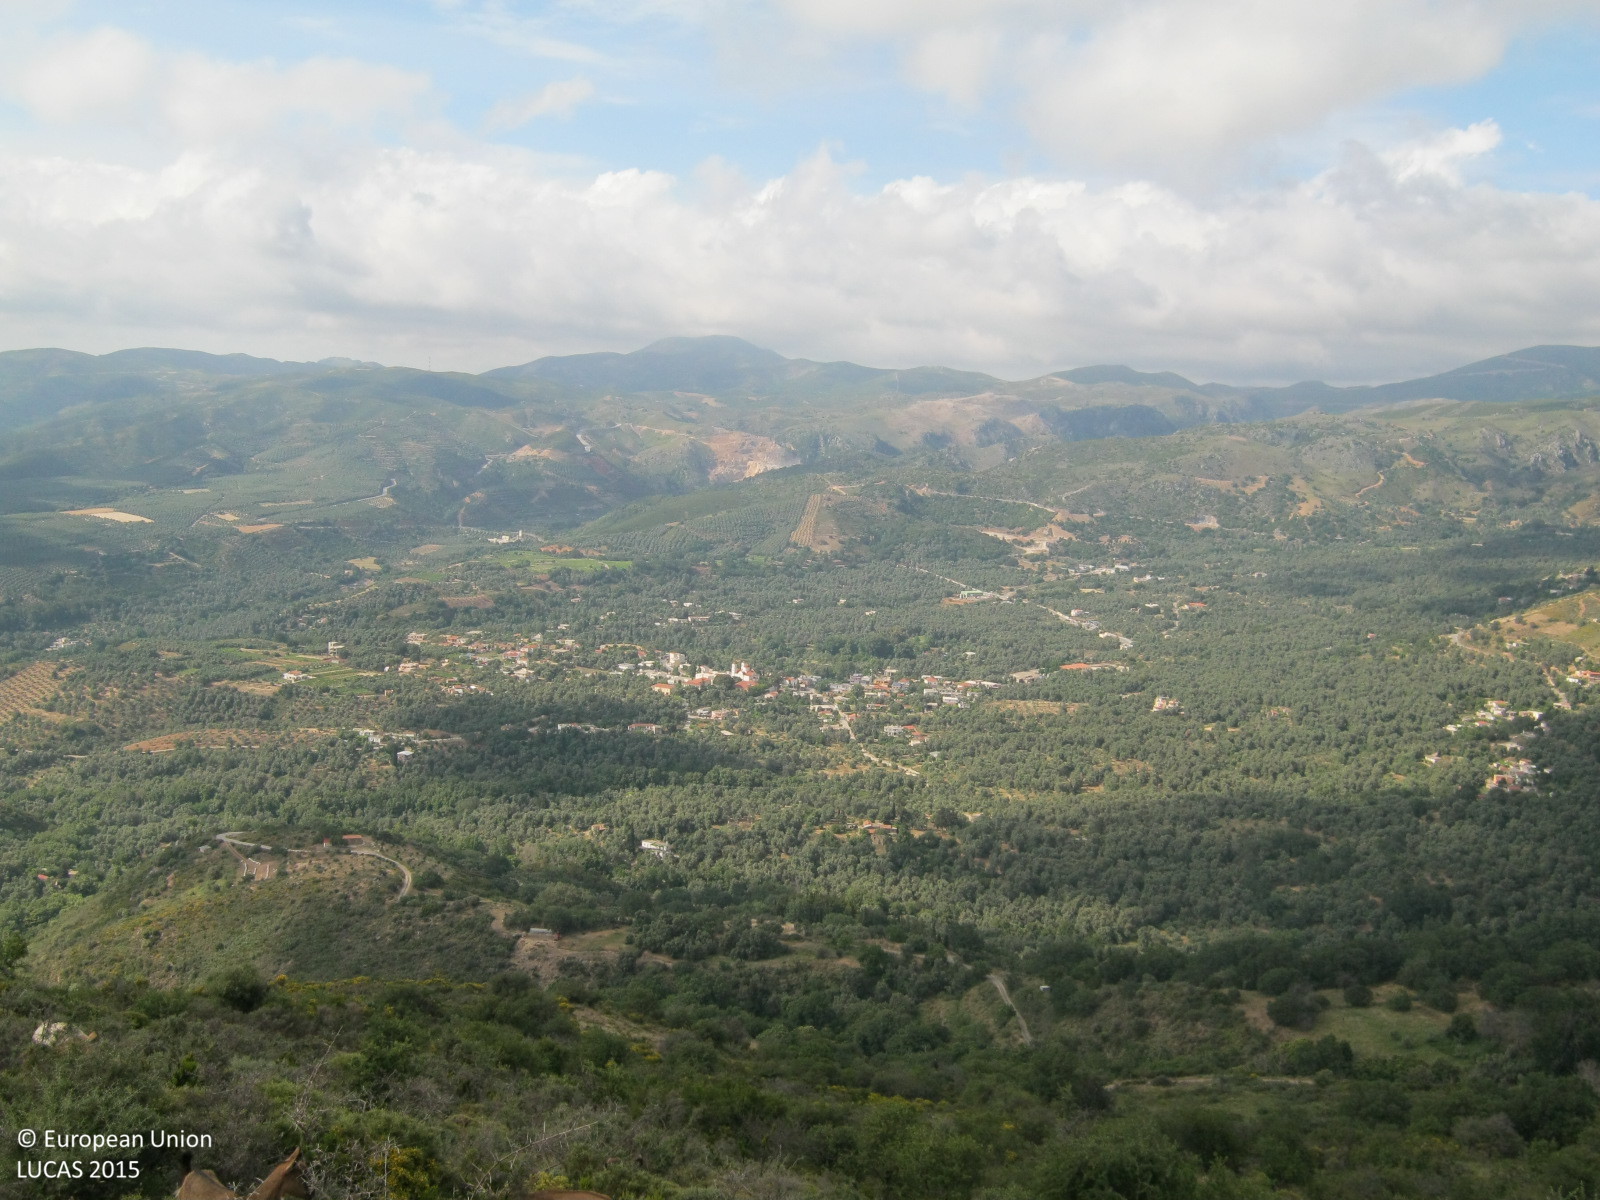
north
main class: Shrubland
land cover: Shrubland with sparse tree cover
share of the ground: > 75 %
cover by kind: shrubs 70 %, unconsolidated bare surface 15 %, herbaceous plants 10 %, broadleaved forest trees 5 %
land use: Agriculture (excluding fallow land and kitchen gardens)
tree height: < 5 m
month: June
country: GR
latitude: 35.3111
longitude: 23.7393
